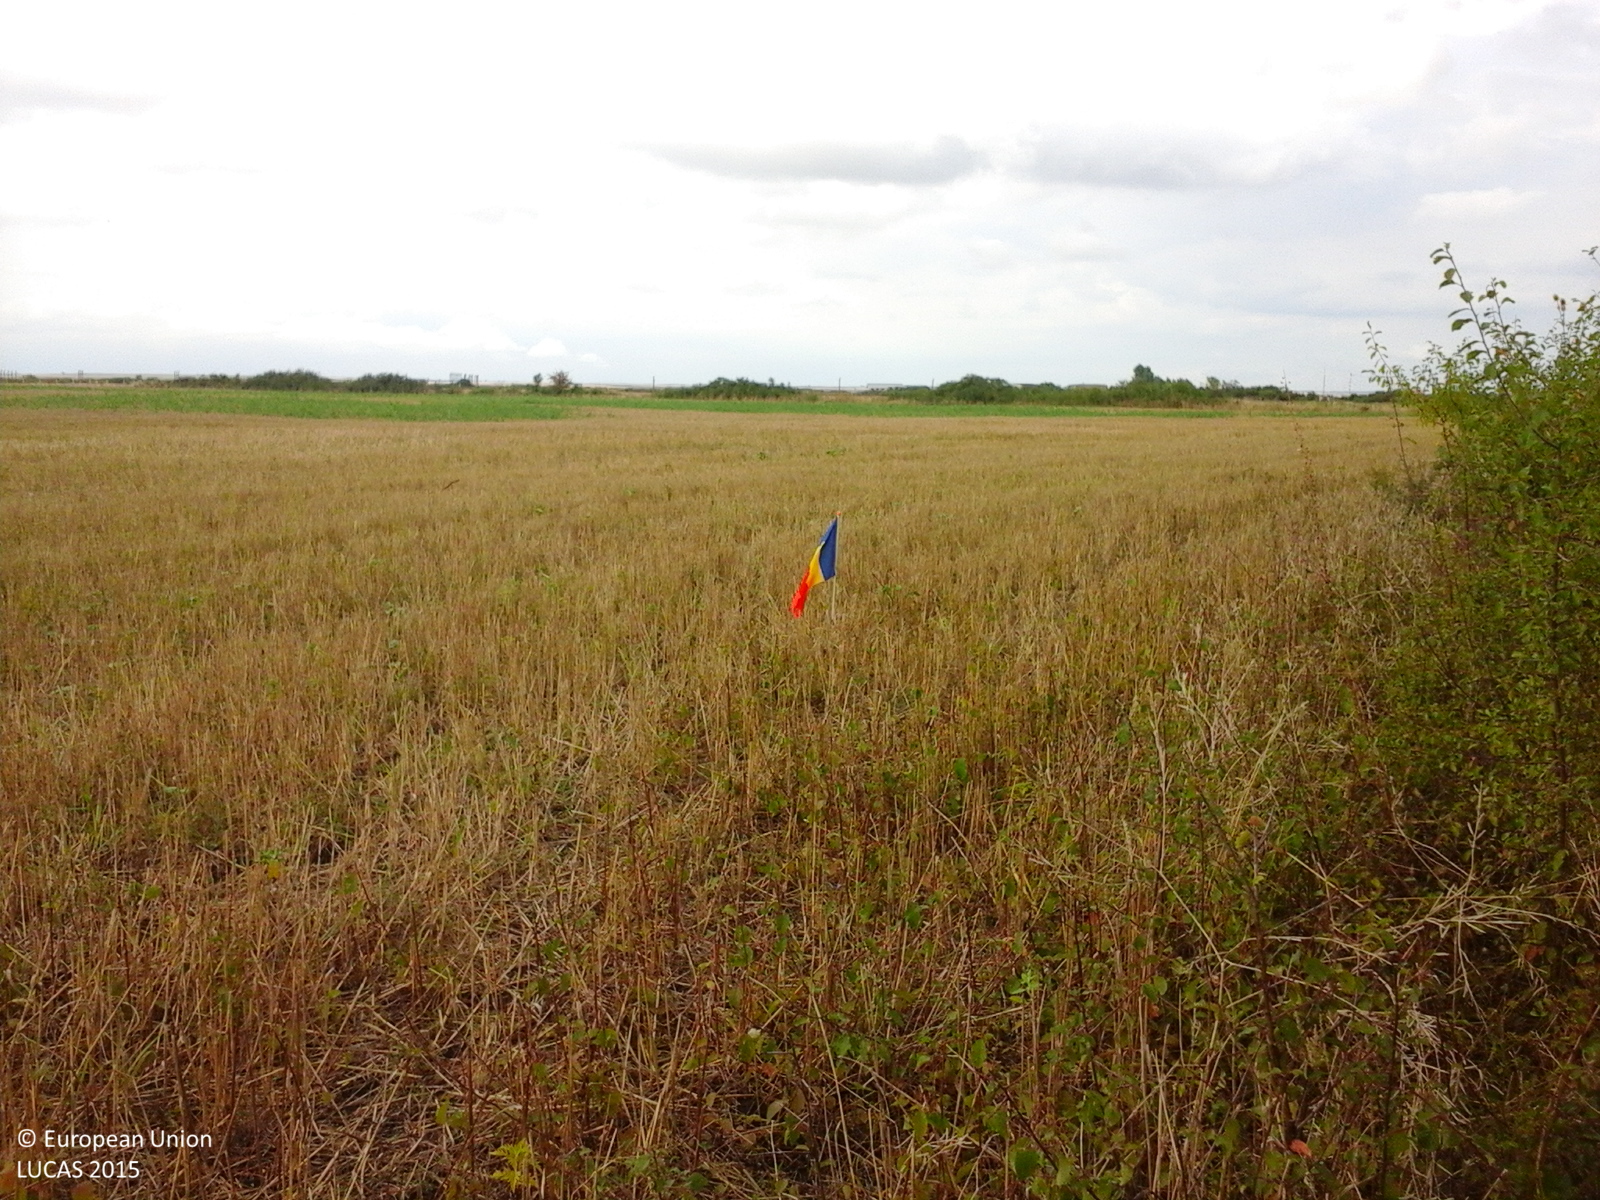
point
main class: Cropland
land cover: Common wheat
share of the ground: 50 - 75 %
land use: Agriculture (excluding fallow land and kitchen gardens)
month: August
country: RO
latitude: 45.7977
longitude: 21.3670
